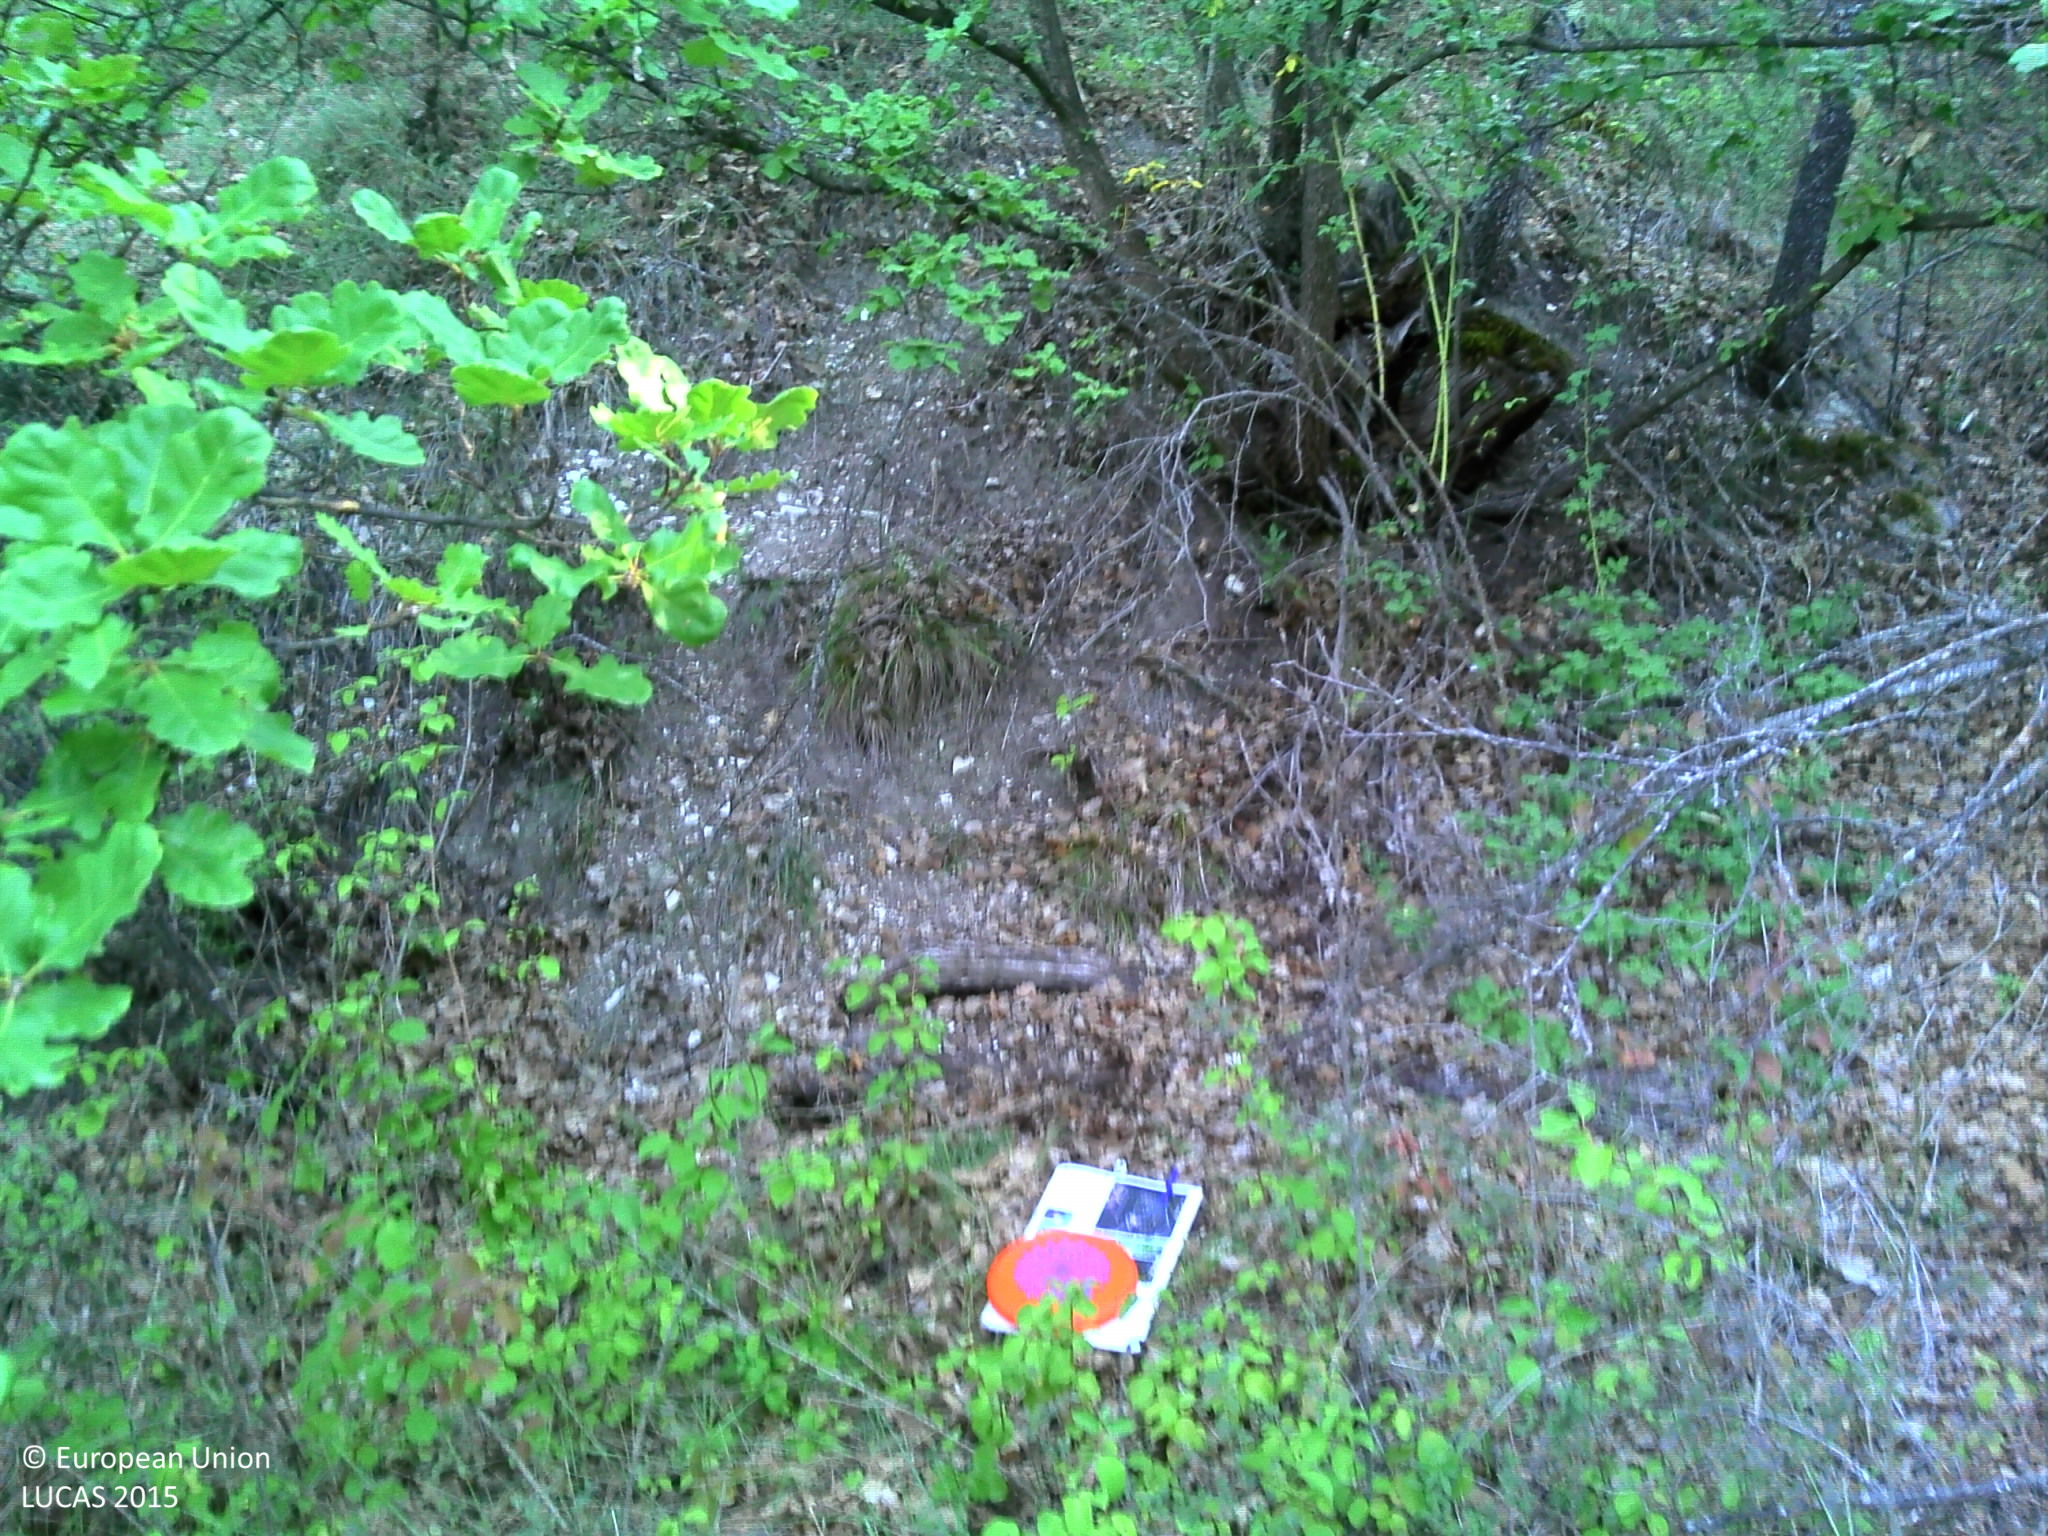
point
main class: Woodland
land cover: Broadleaved woodland
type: broadleaved evergreen forest
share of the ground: > 75 %
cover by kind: broadleaved forest trees 65 %, shrubs 15 %, coniferous forest trees 10 %, herbaceous plants 10 %
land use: Semi-natural and natural areas not in use
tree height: > 5 m
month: August
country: FR
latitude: 43.9218
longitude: 5.3630
